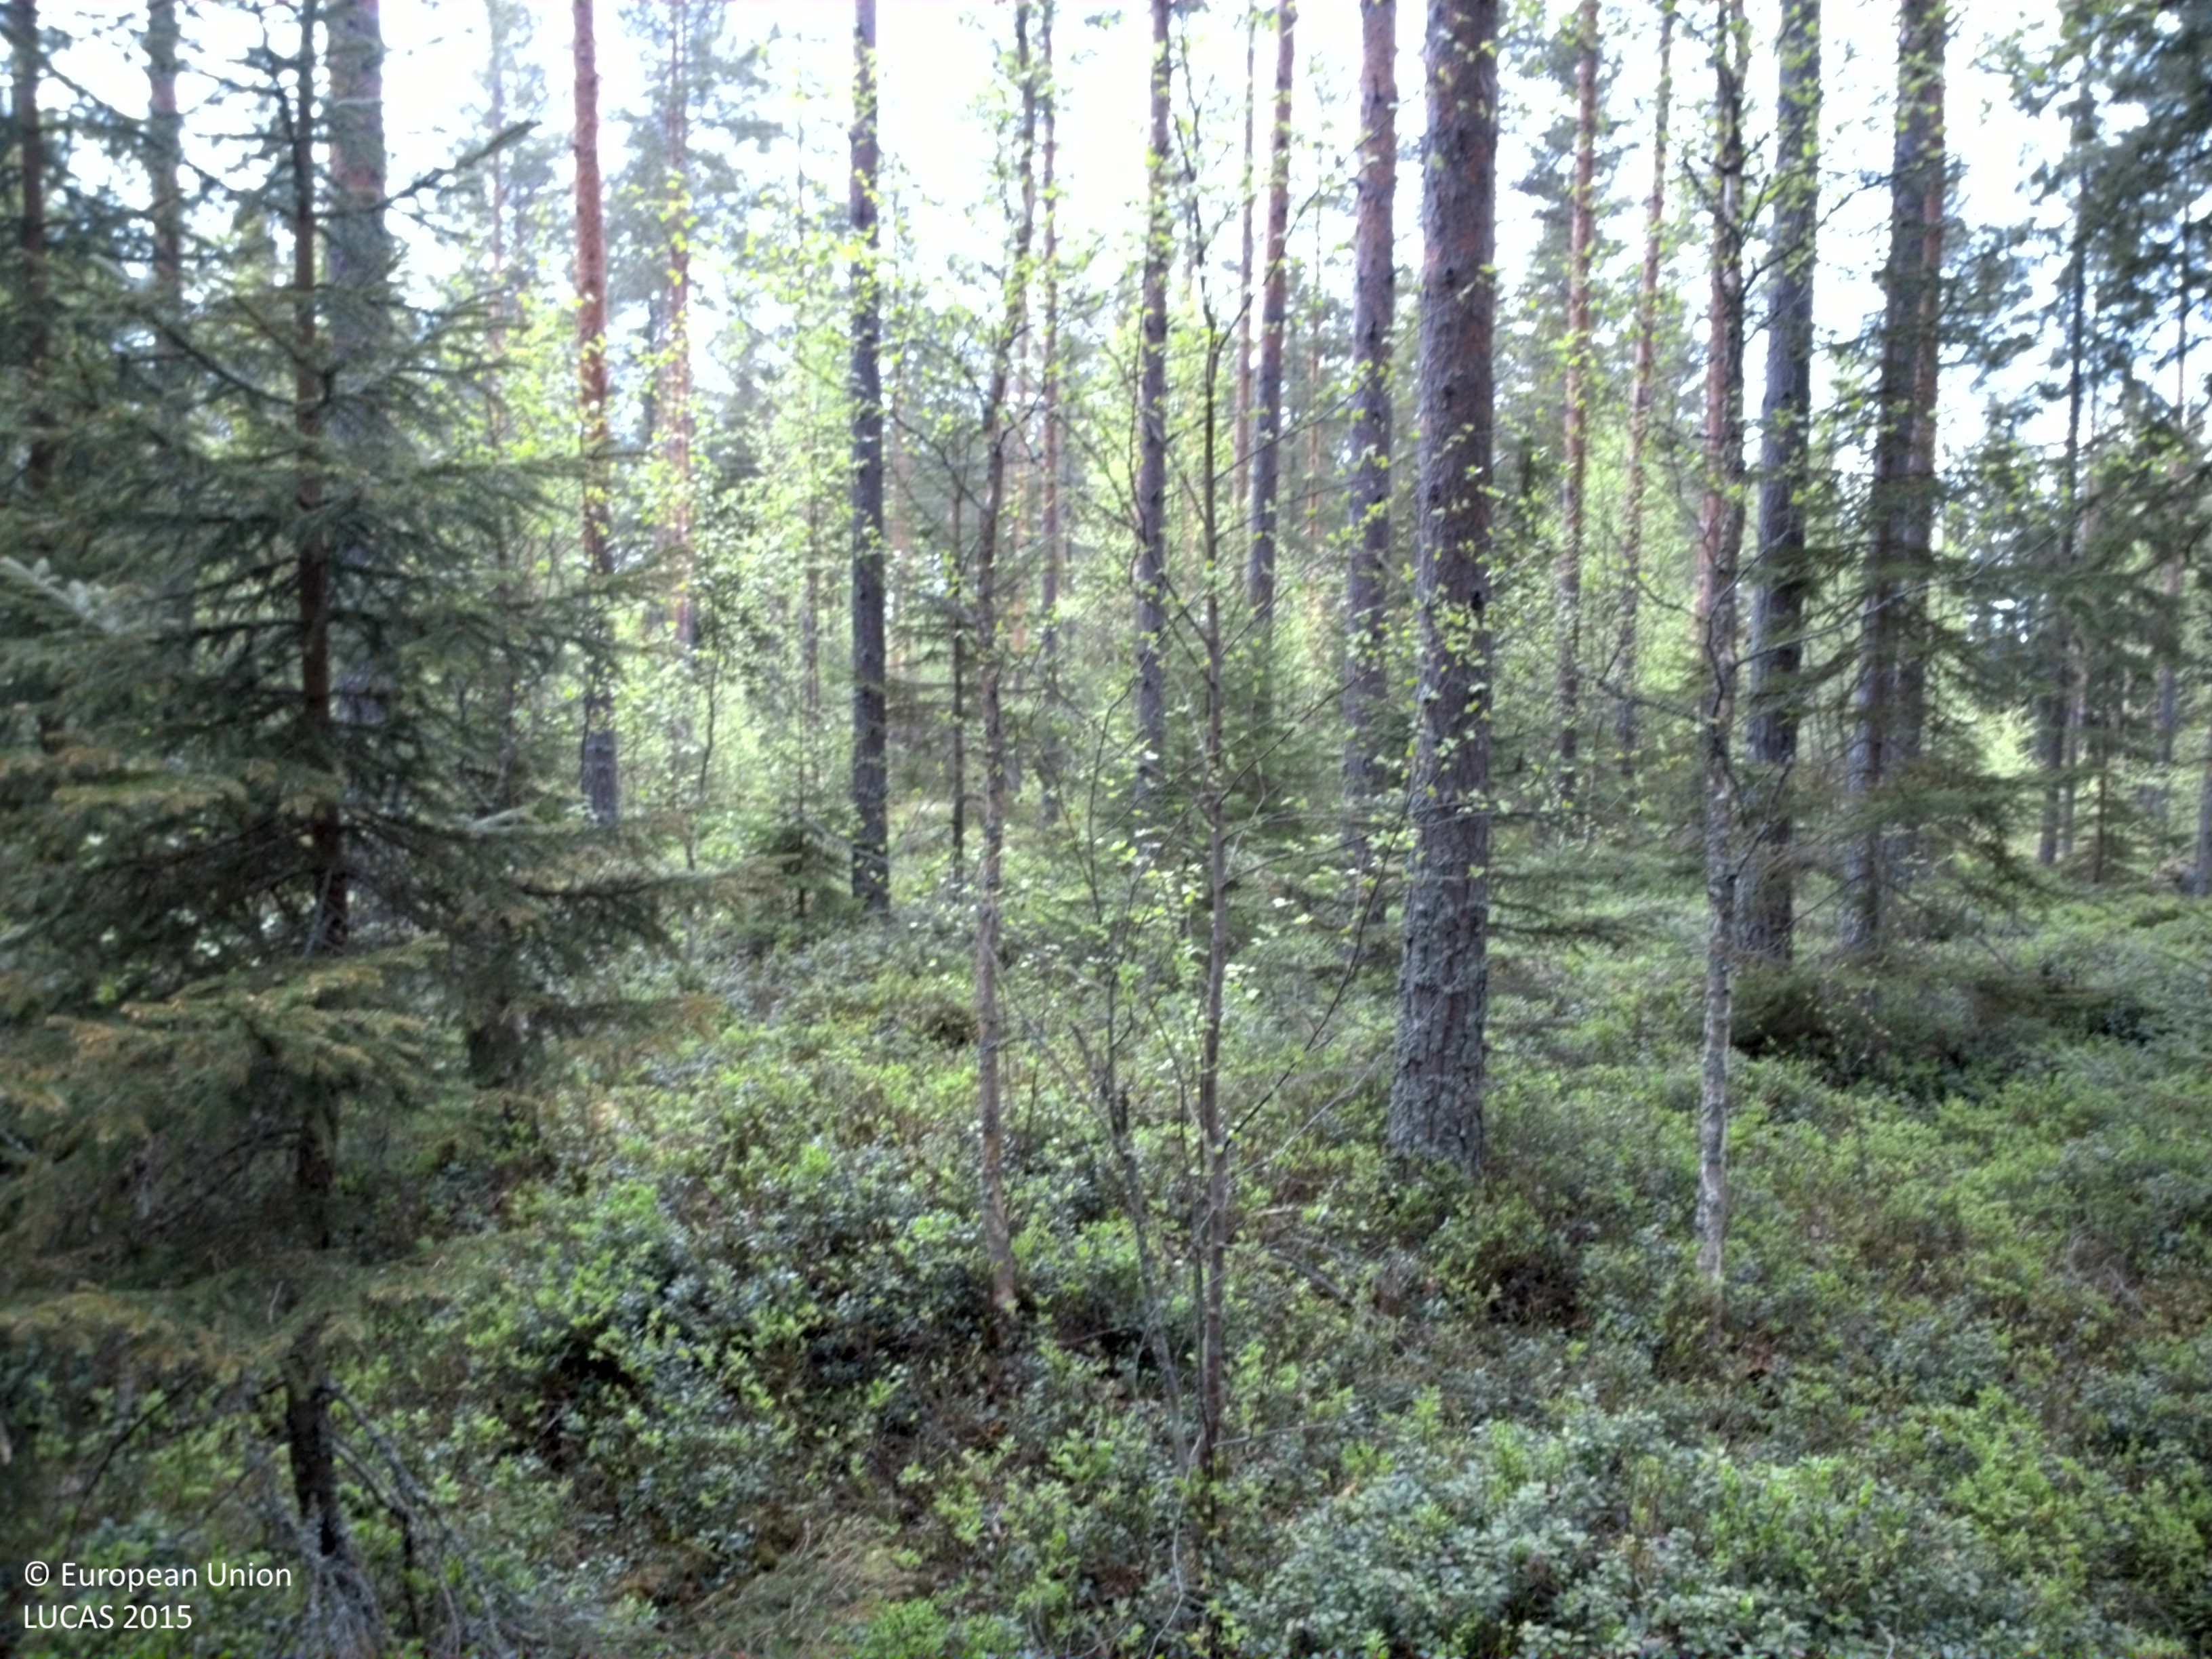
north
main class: Woodland
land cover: Pine dominated coniferous woodland
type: boreal forest
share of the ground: 50 - 75 %
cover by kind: coniferous forest trees 60 %, shrubs 30 %, broadleaved forest trees 10 %
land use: Forestry
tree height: > 5 m
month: May
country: SE
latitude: 61.1966
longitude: 15.3995
